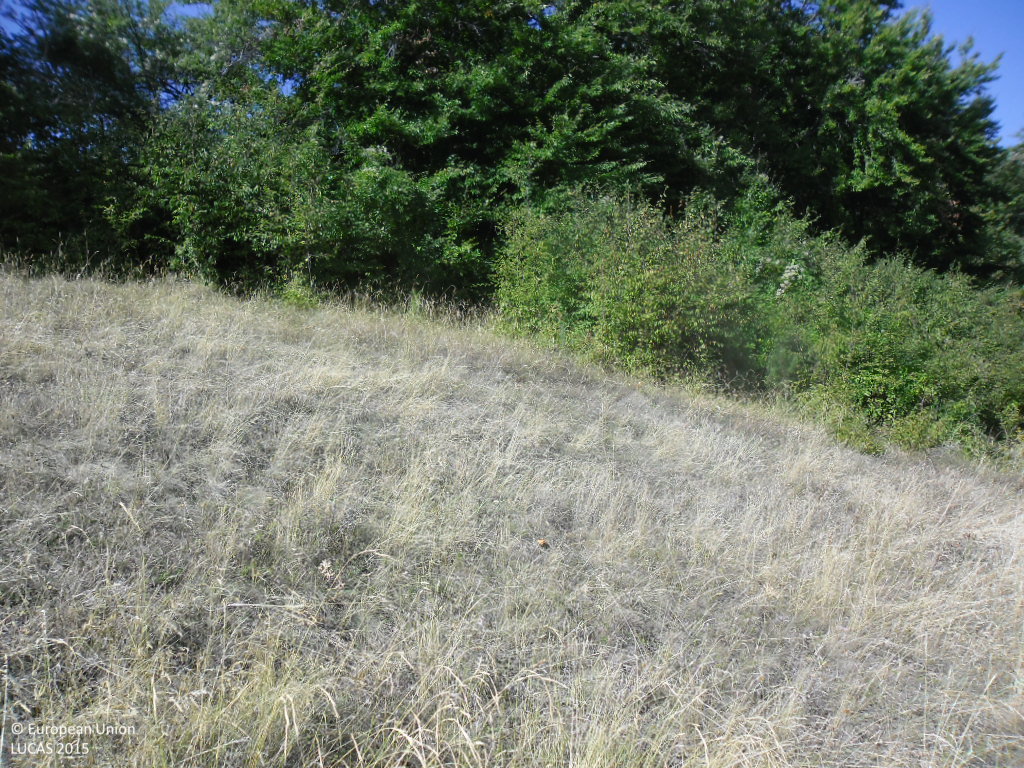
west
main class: Grassland
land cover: Grassland with sparse tree/shrub cover
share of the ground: > 75 %
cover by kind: herbaceous plants 90 %, broadleaved forest trees 5 %, shrubs 5 %
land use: Agriculture (excluding fallow land and kitchen gardens)
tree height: < 5 m
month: September
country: BG
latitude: 41.8737
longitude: 22.9494
